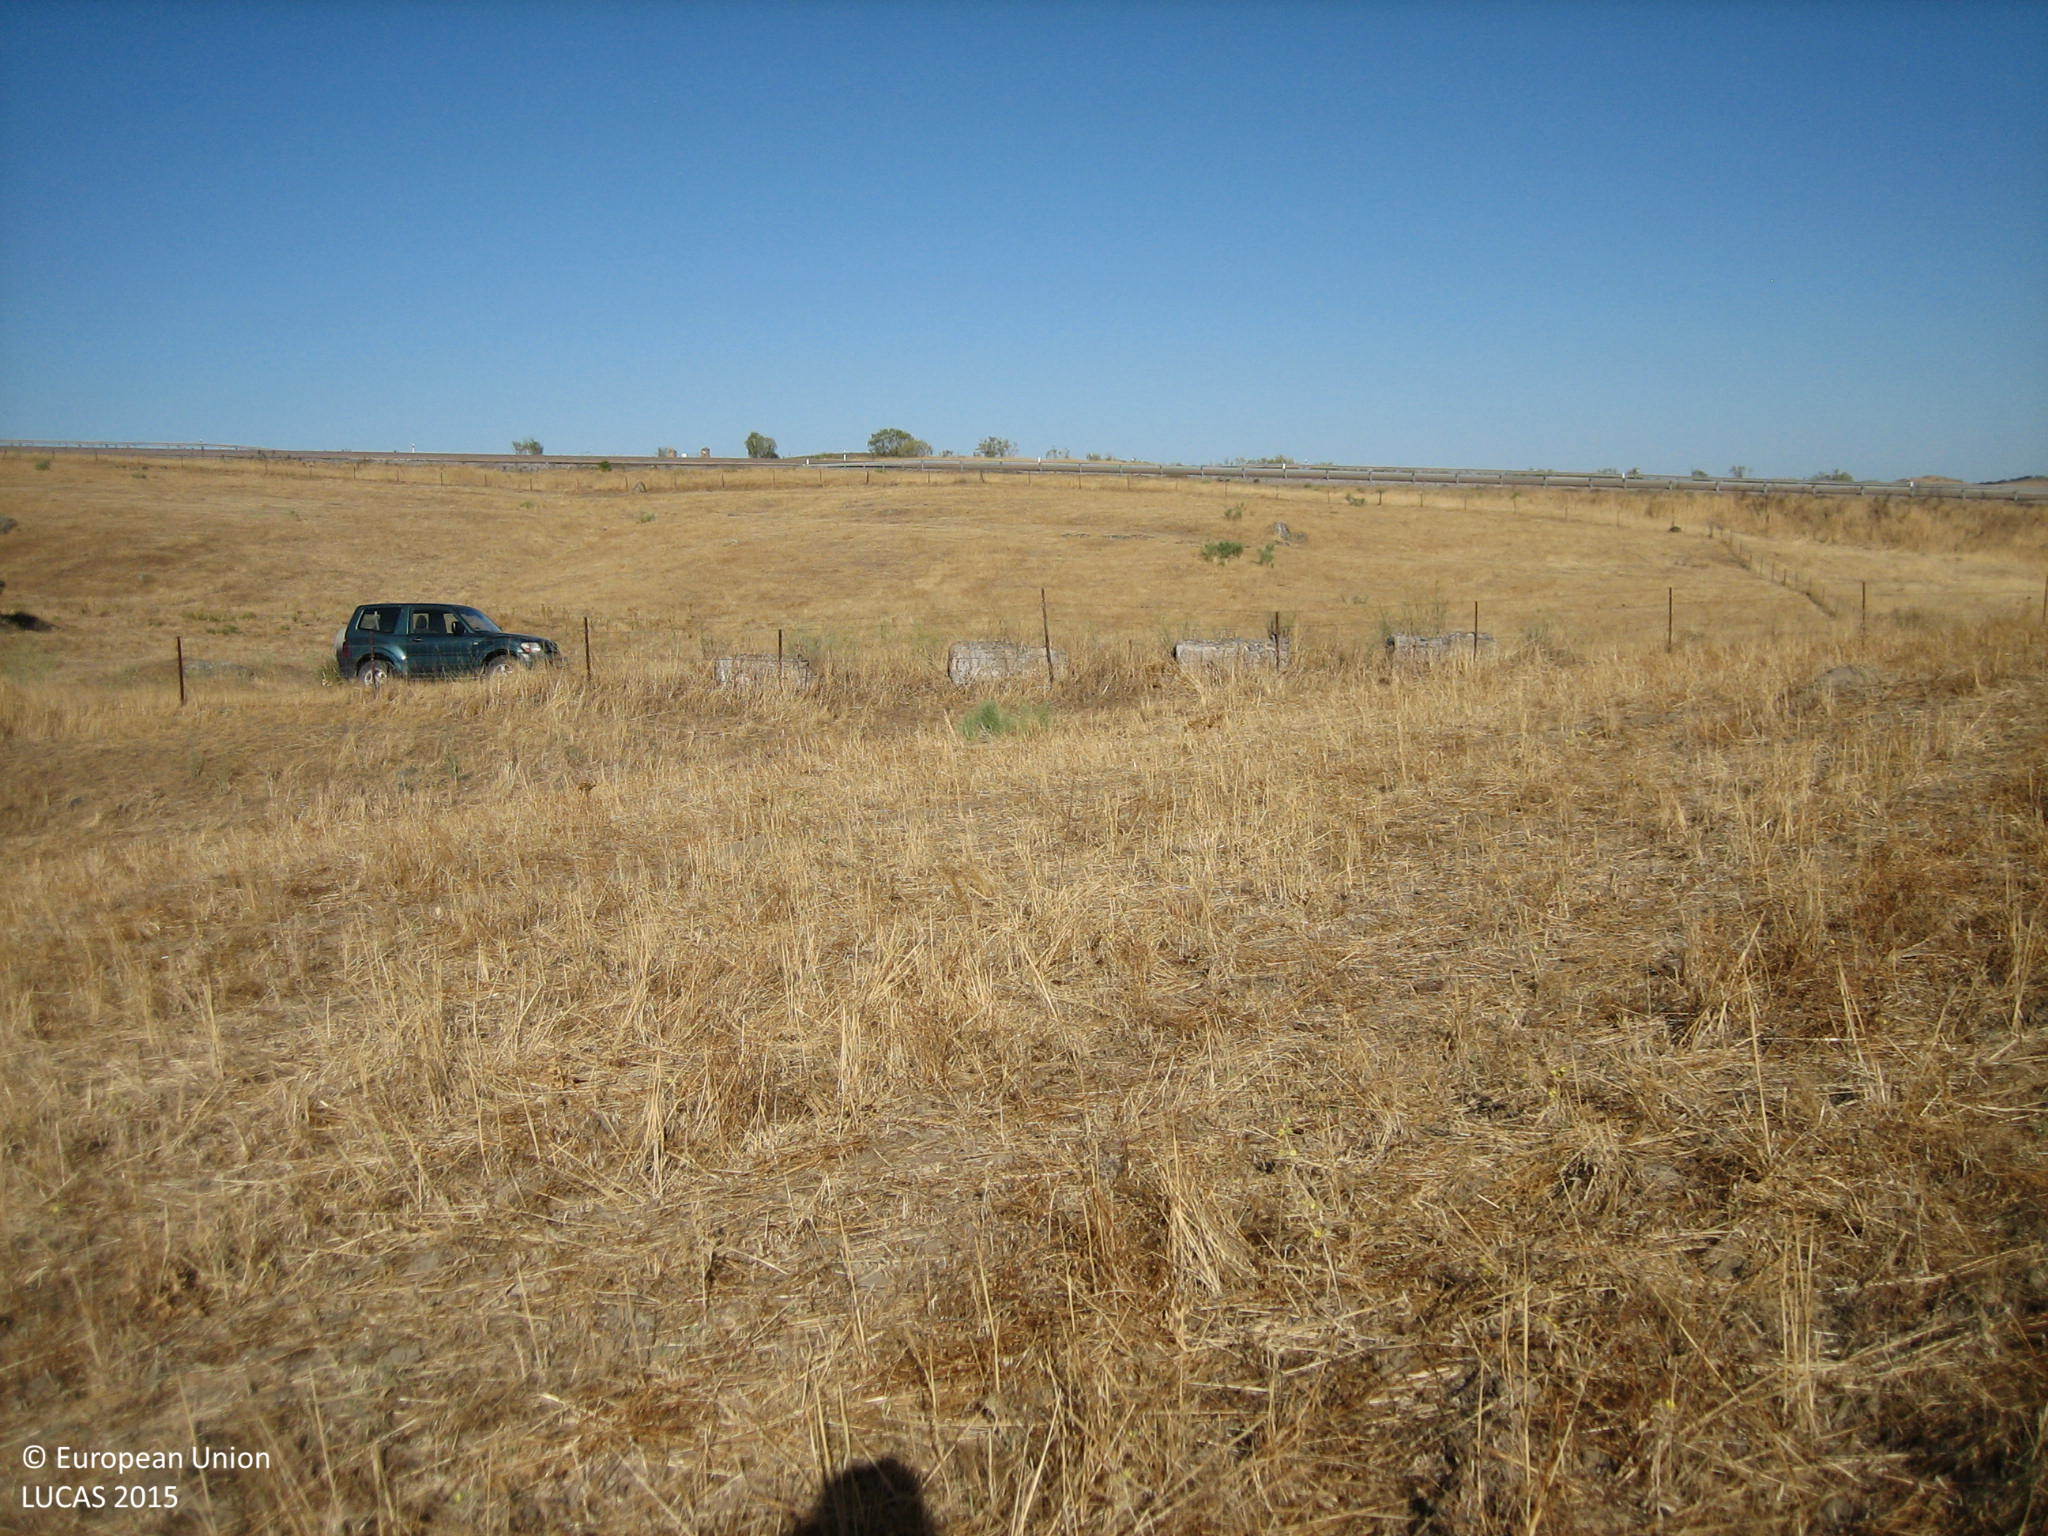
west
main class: Grassland
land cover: Grassland without tree/shrub cover
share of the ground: > 75 %
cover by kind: herbaceous plants 80 %, consolidated bare surface 20 %
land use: Agriculture (excluding fallow land and kitchen gardens)
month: August
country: ES
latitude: 38.1420
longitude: -6.2792
